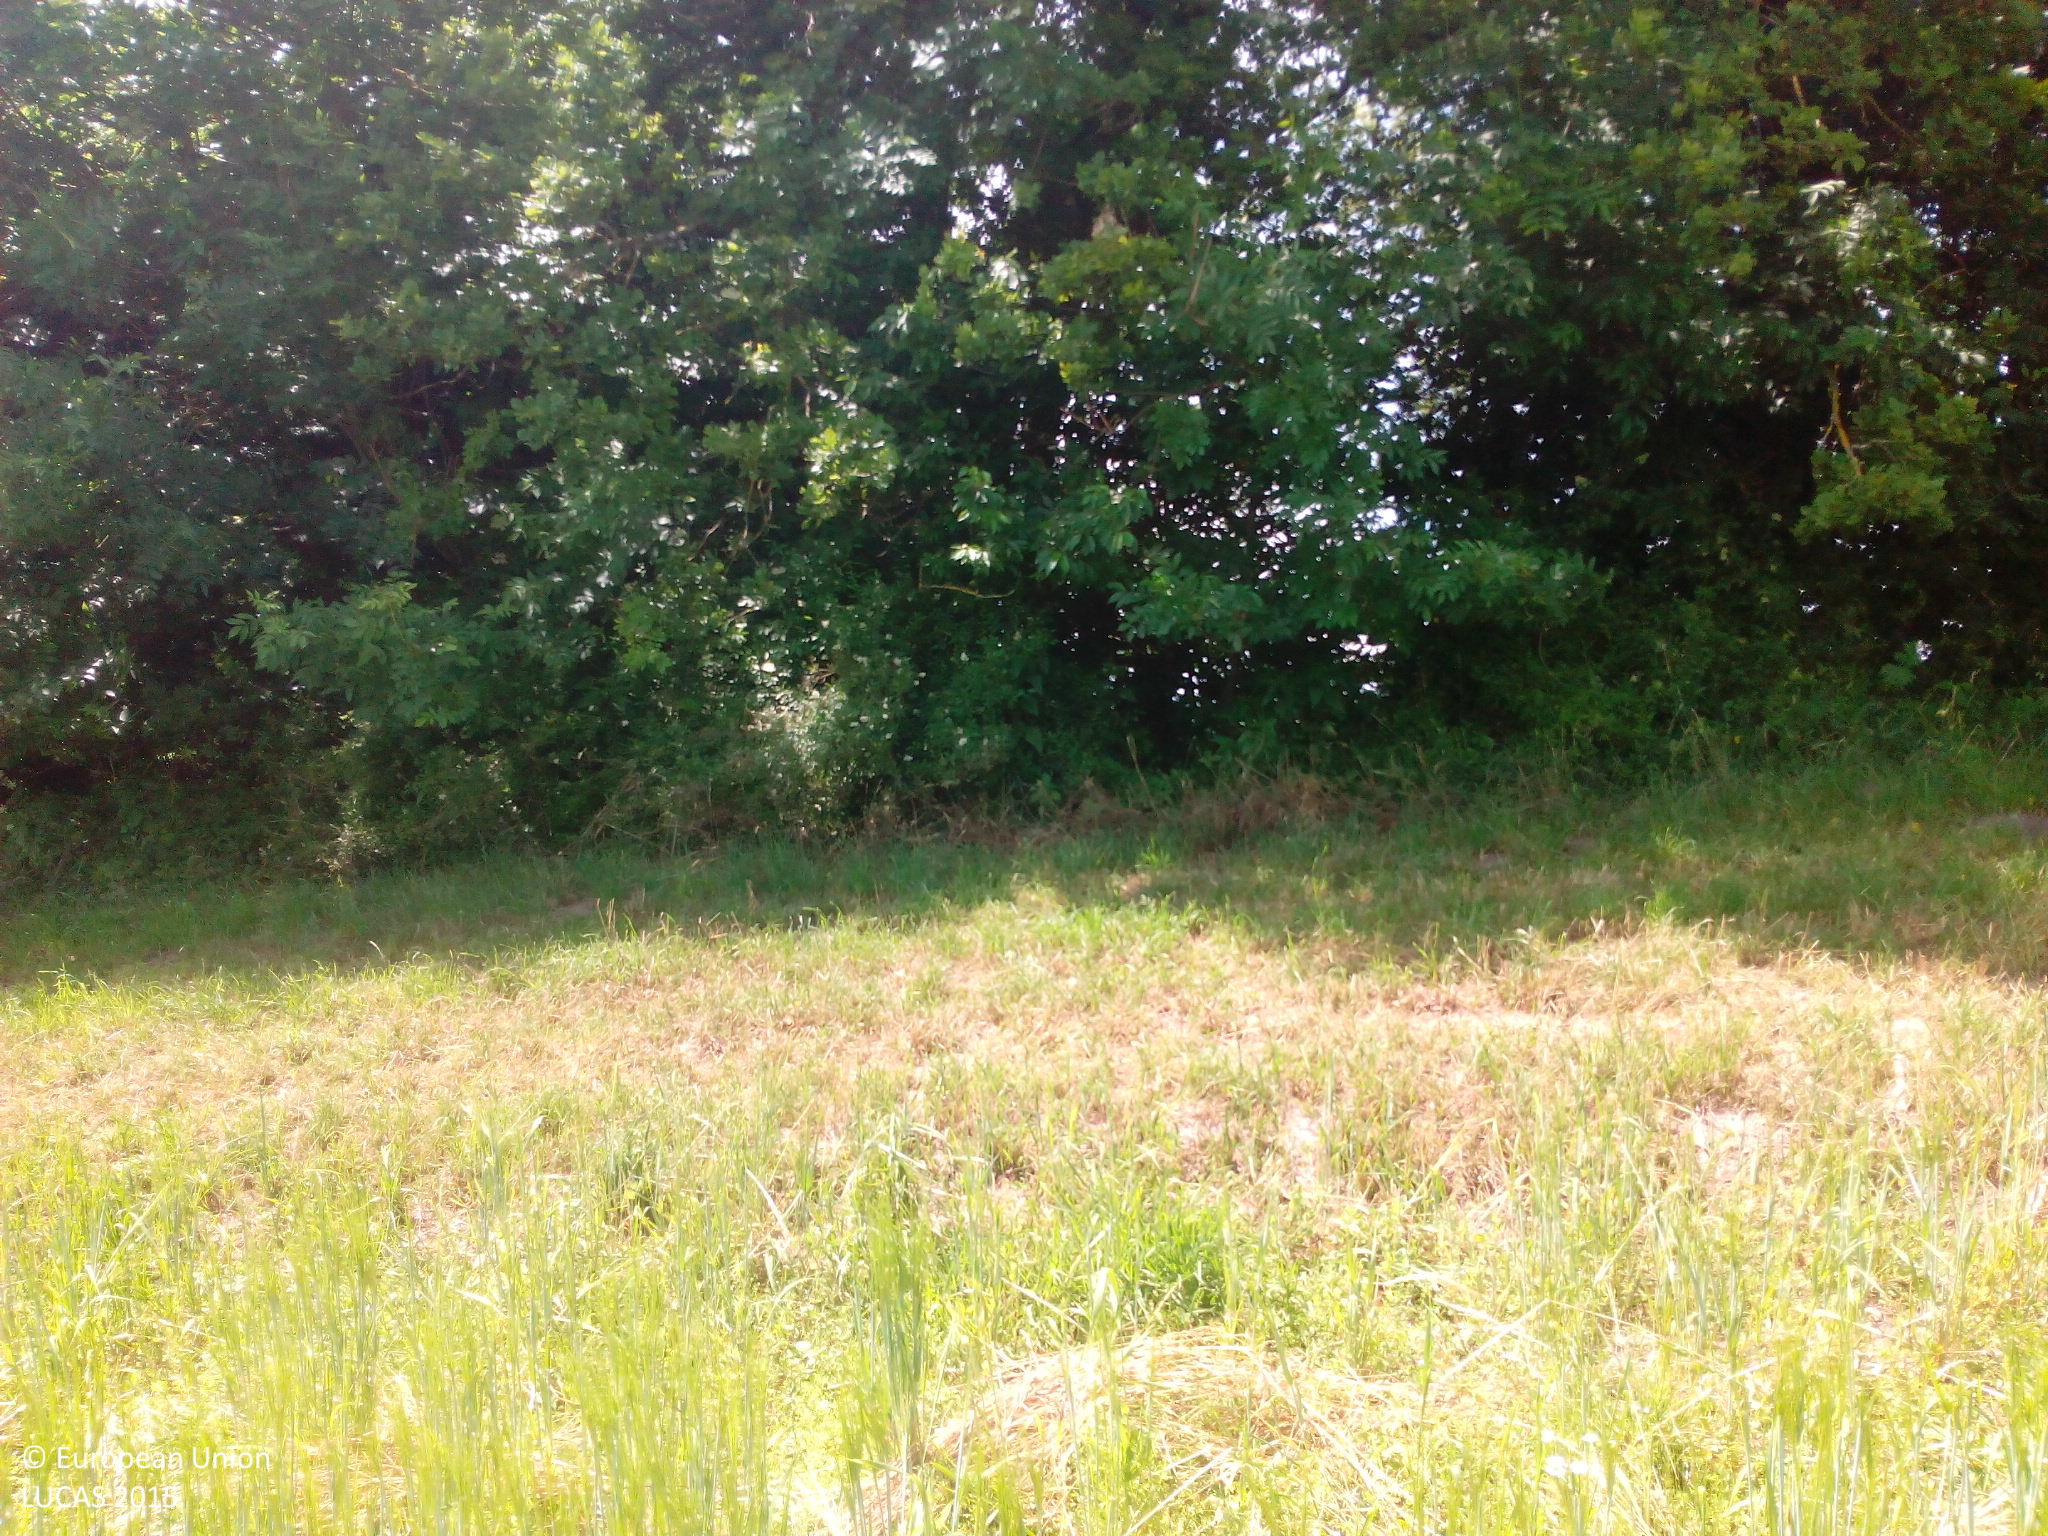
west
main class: Cropland
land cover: Barley
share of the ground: > 75 %
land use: Agriculture (excluding fallow land and kitchen gardens)
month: June
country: DE
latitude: 47.7912
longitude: 9.6932
